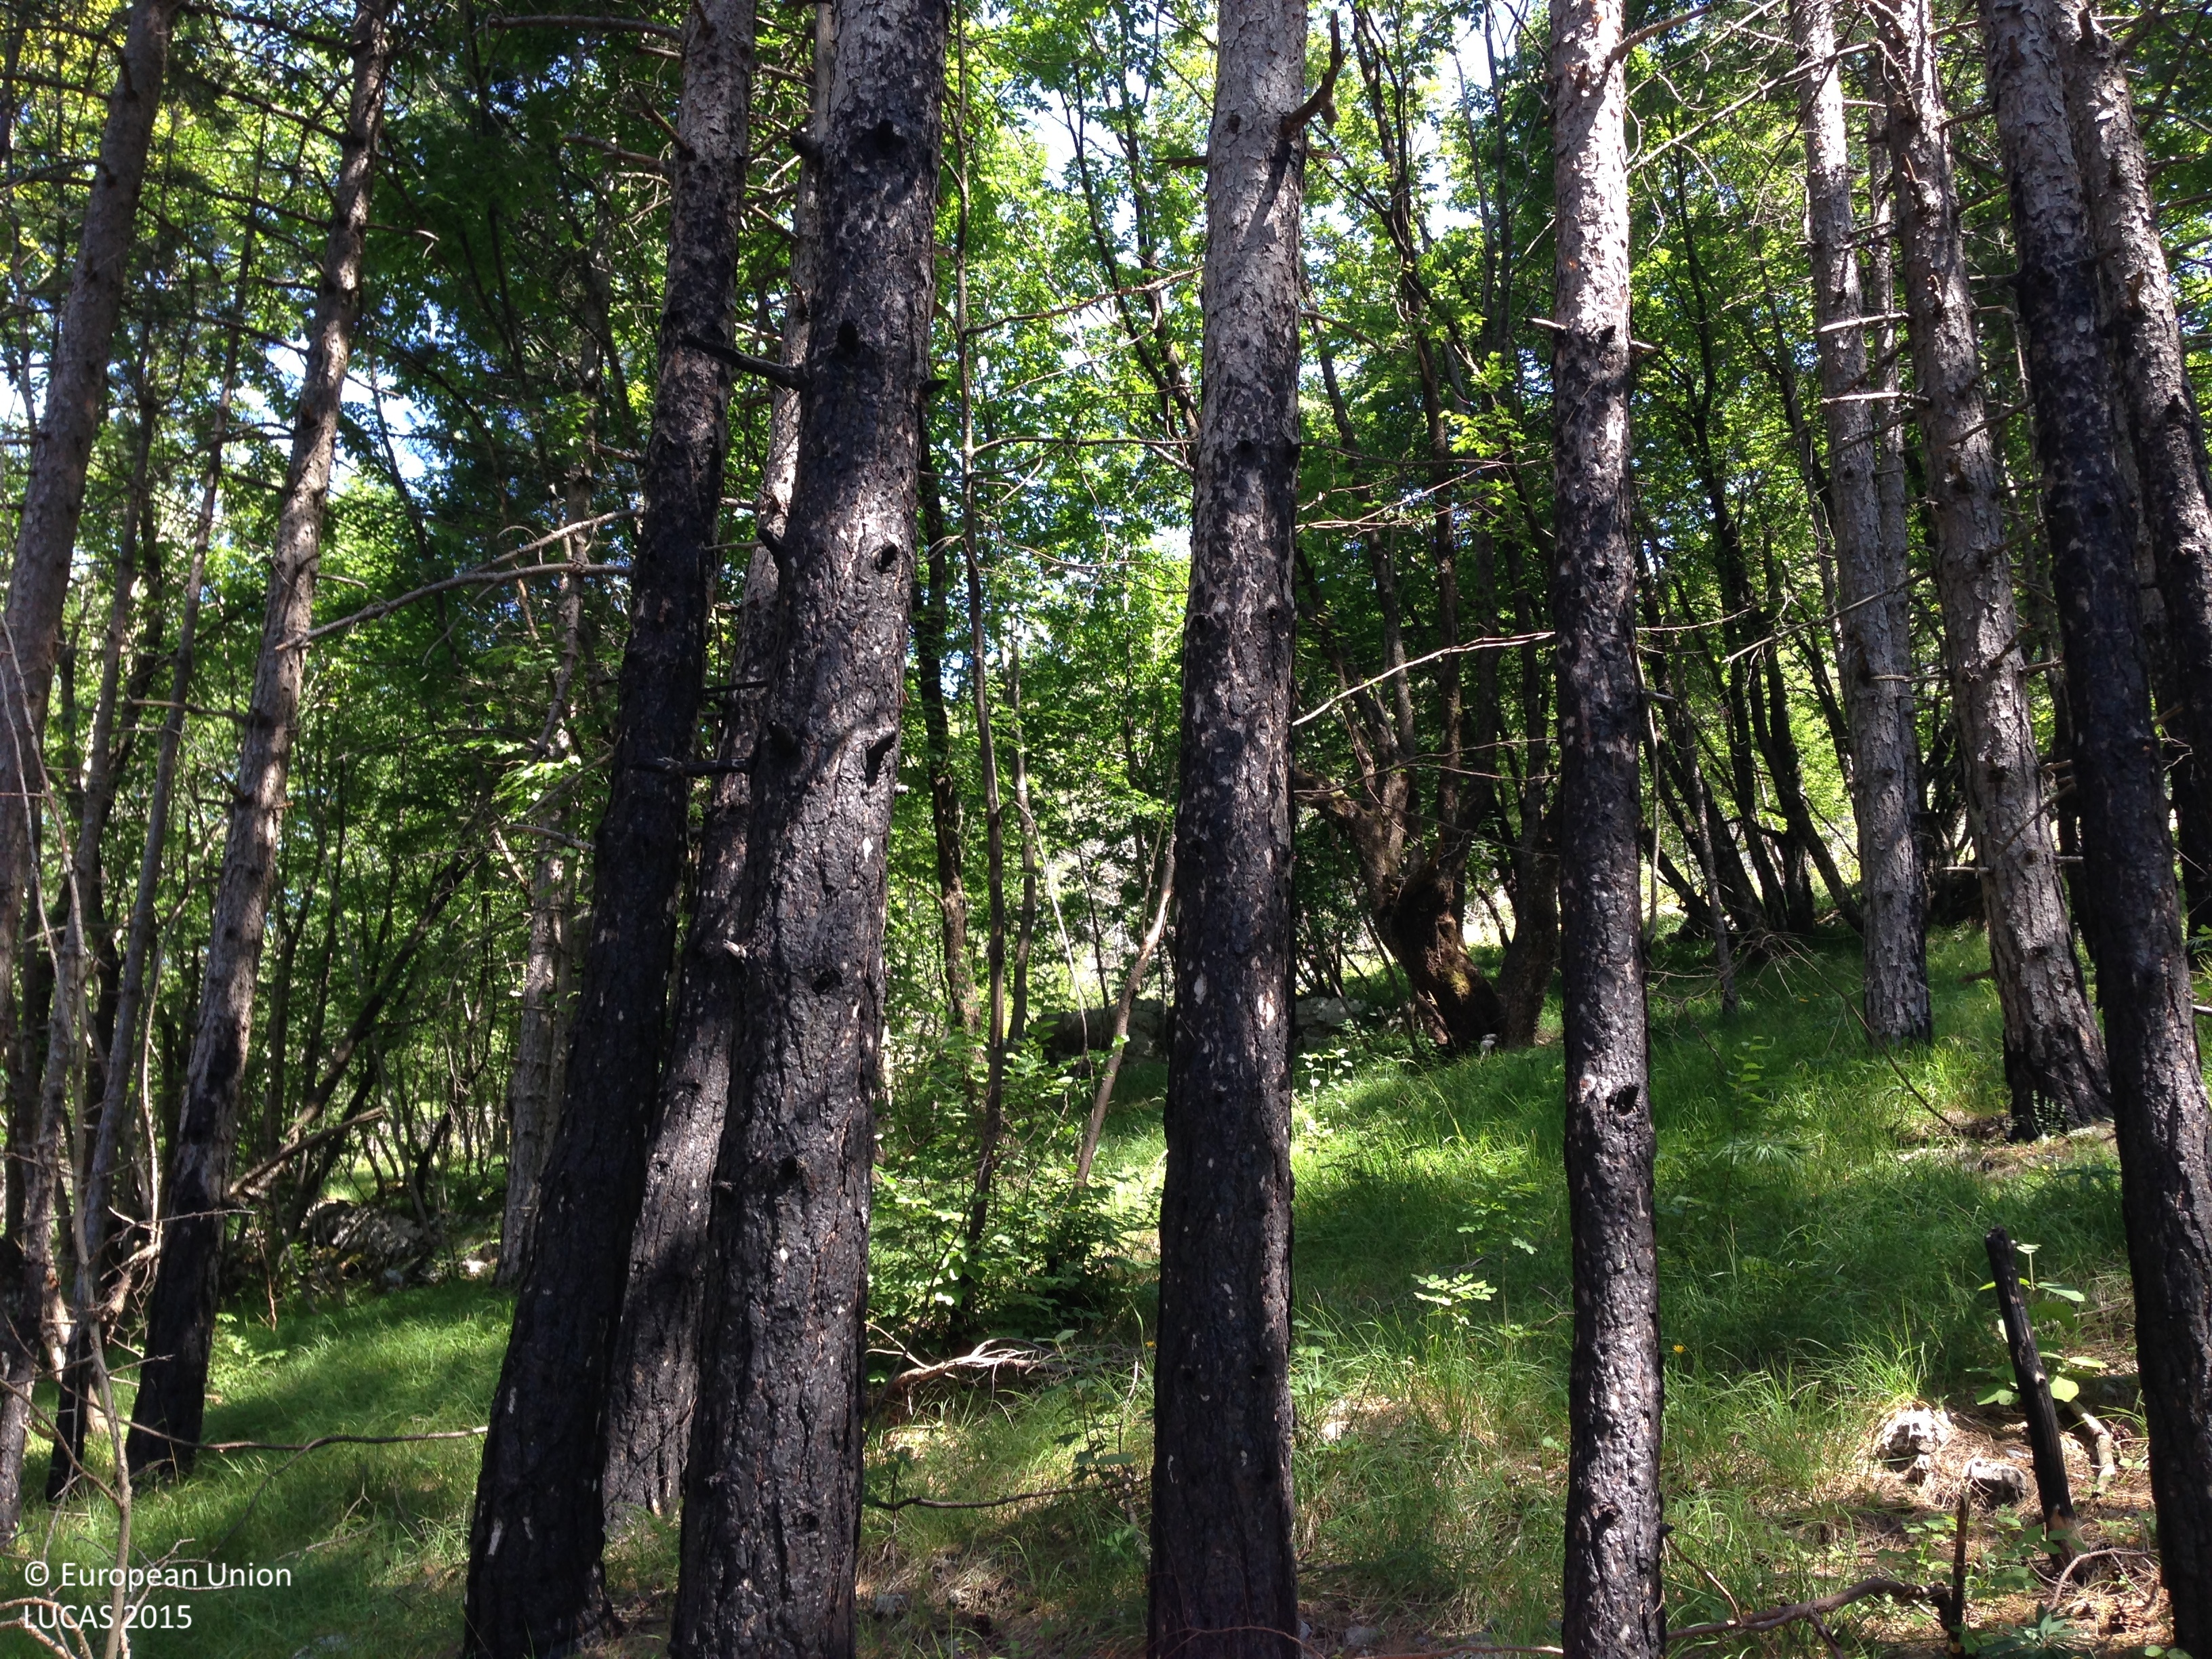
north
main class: Woodland
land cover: Pine dominated coniferous woodland
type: coniferous forest of the mediterranean region
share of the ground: > 75 %
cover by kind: coniferous forest trees 45 %, herbaceous plants 20 %, broadleaved forest trees 15 %, shrubs 5 %, lichens and mosses 5 %, consolidated bare surface 5 %, unconsolidated bare surface 5 %
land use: Forestry
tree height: > 5 m
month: July
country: HR
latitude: 44.6742
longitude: 15.1530
